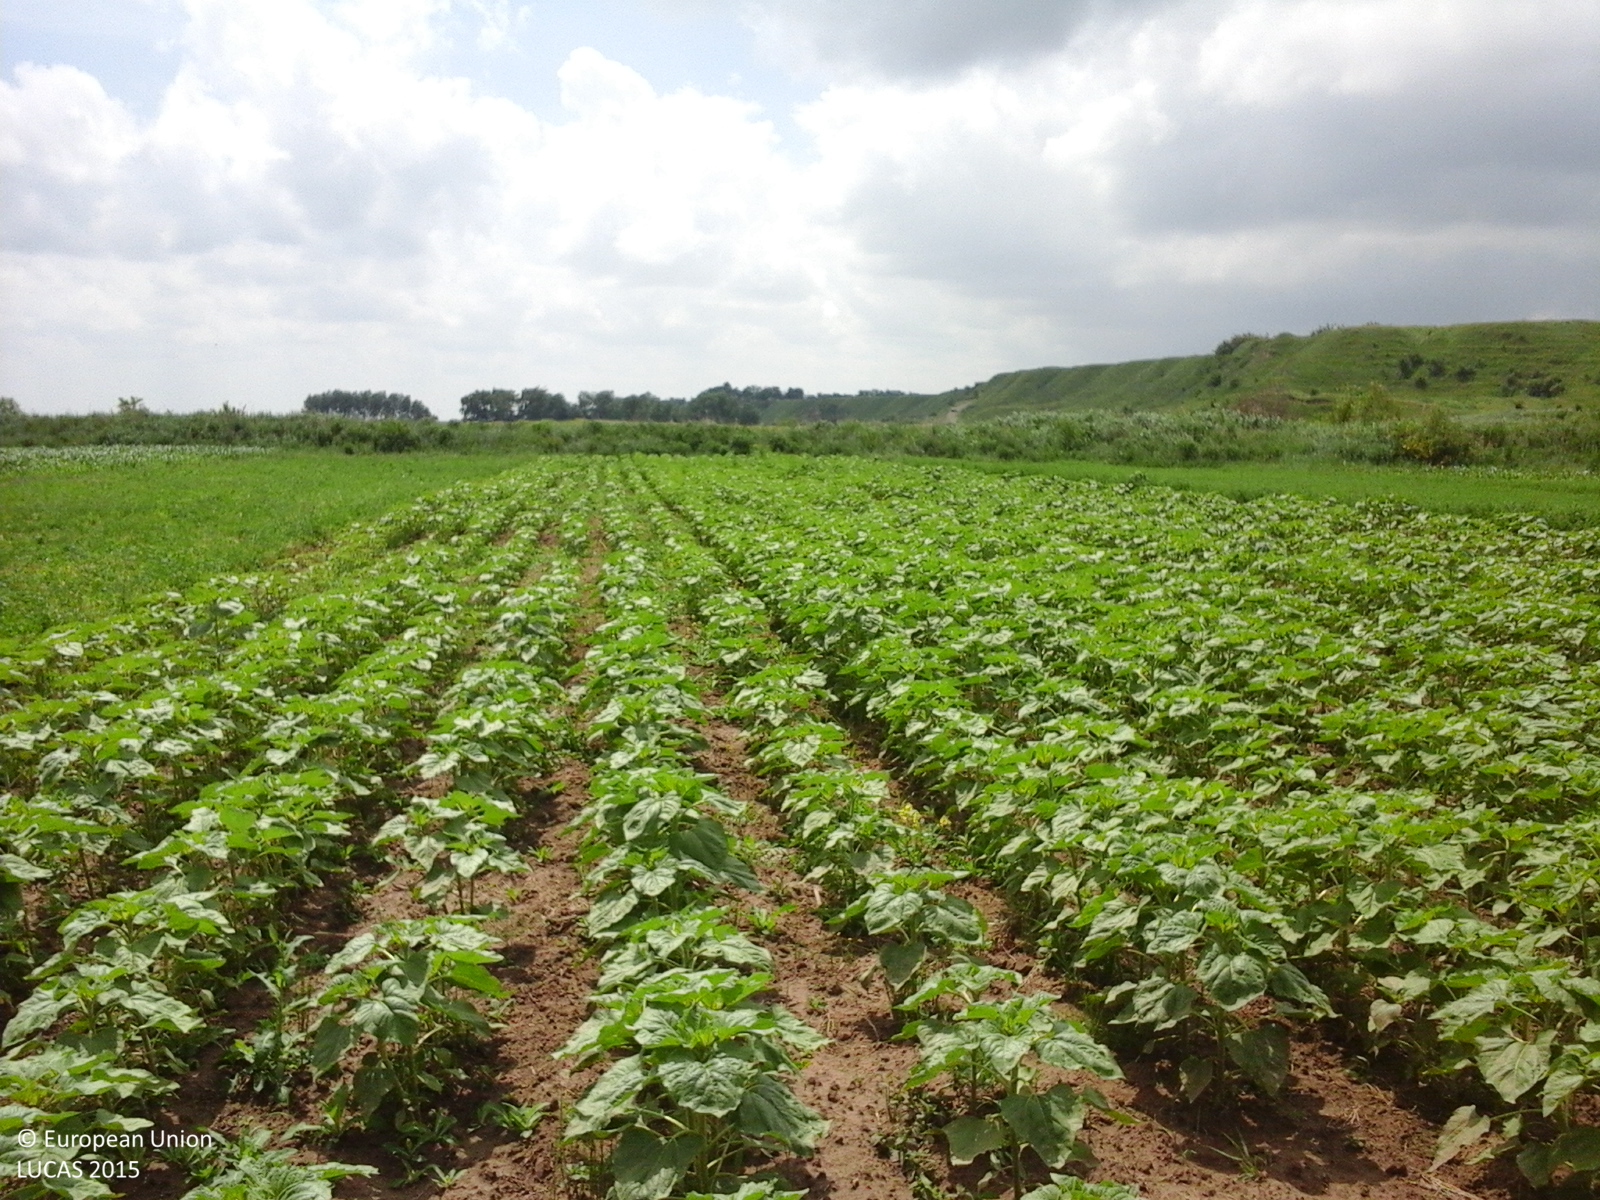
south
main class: Cropland
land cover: Sunflower
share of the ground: 50 - 75 %
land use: Agriculture (excluding fallow land and kitchen gardens)
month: June
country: RO
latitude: 47.1852
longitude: 26.7615
